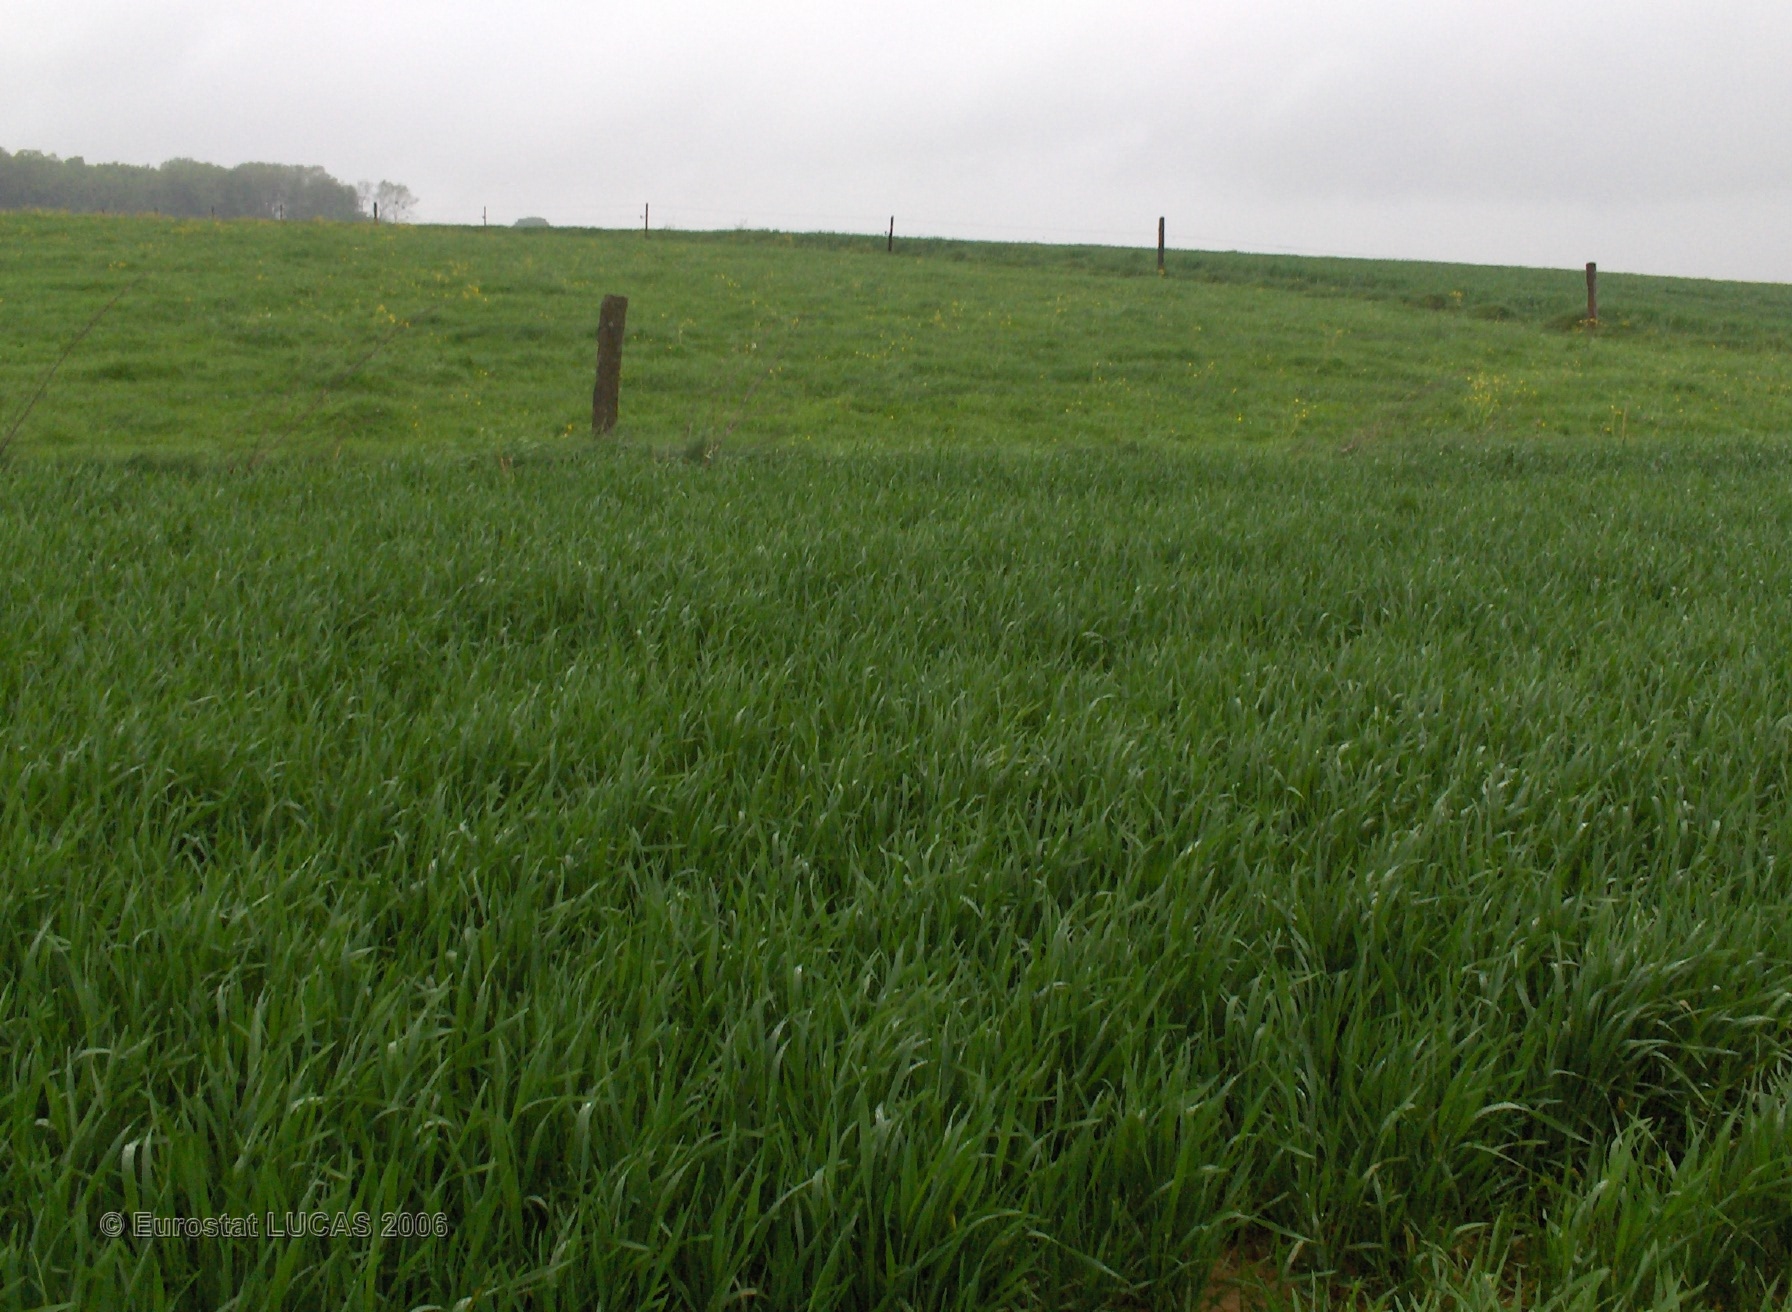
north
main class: Cropland
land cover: Common wheat
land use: Agriculture (excluding fallow land and kitchen gardens)
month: May
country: BE
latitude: 50.3548
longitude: 5.2330
